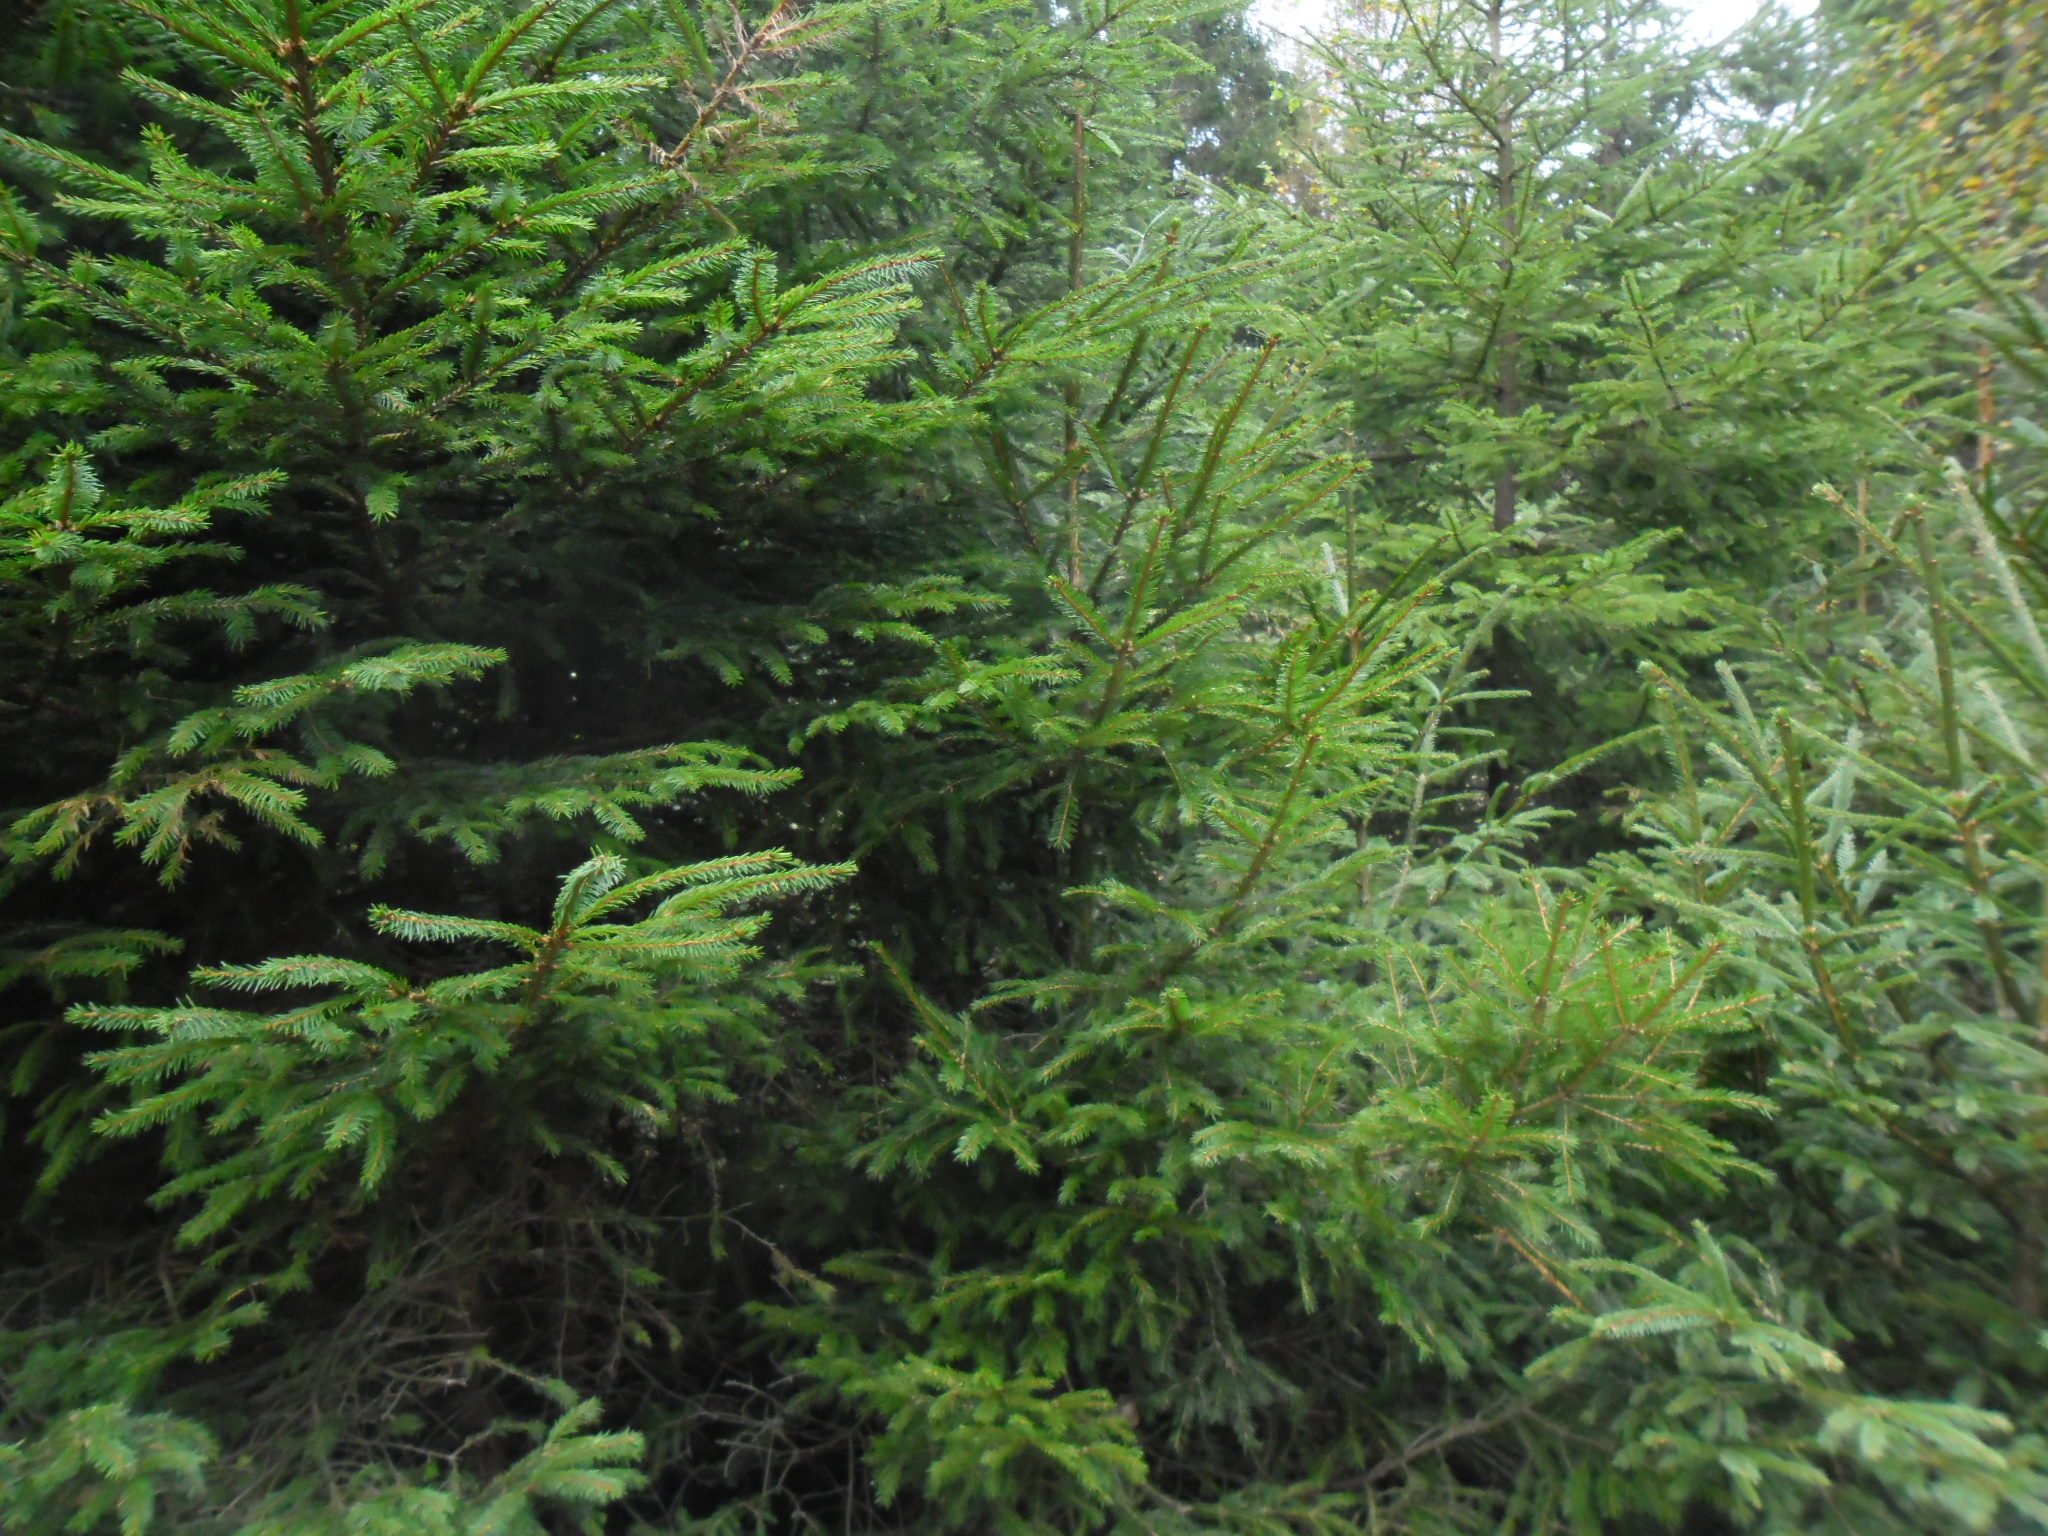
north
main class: Woodland
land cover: Spruce dominated coniferous woodland
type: boreal forest
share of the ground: > 75 %
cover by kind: coniferous forest trees 100 %
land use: Forestry
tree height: > 5 m
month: October
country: SE
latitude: 56.3674
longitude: 13.7368
